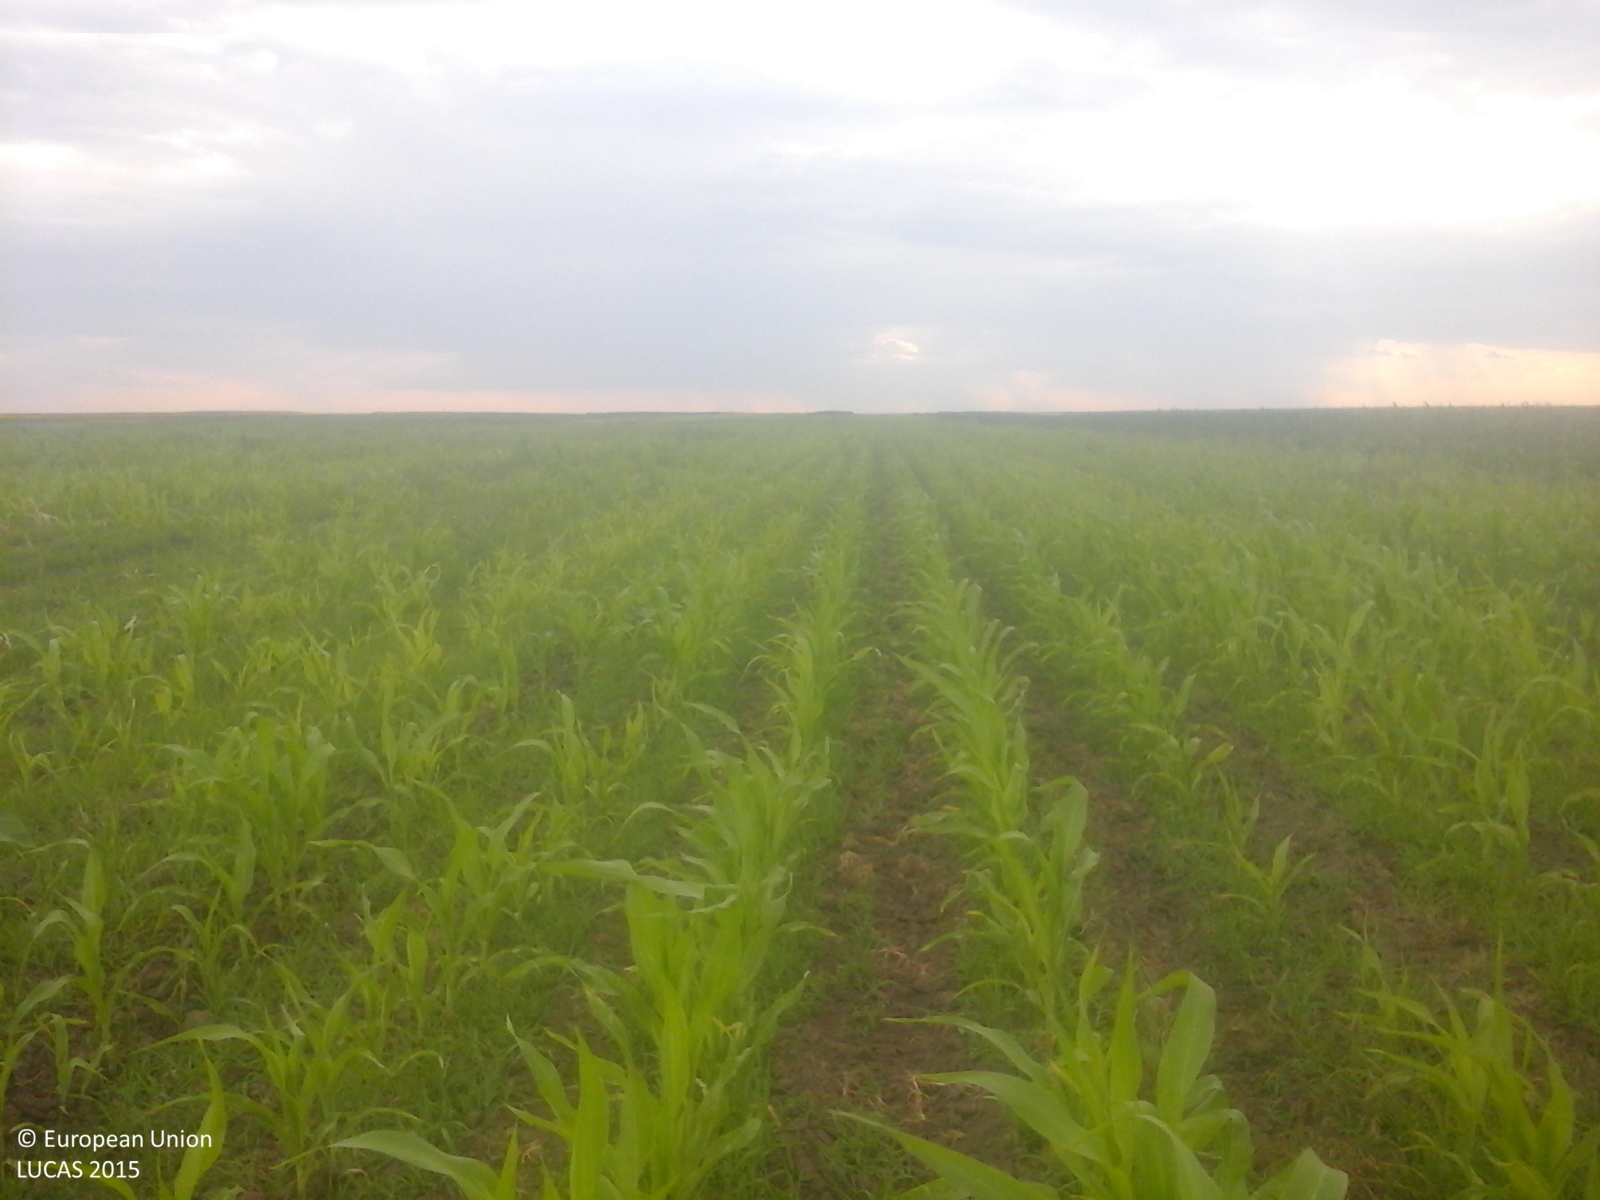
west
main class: Cropland
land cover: Maize
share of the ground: < 10 %
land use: Agriculture (excluding fallow land and kitchen gardens)
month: July
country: RO
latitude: 44.0969
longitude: 25.3616
